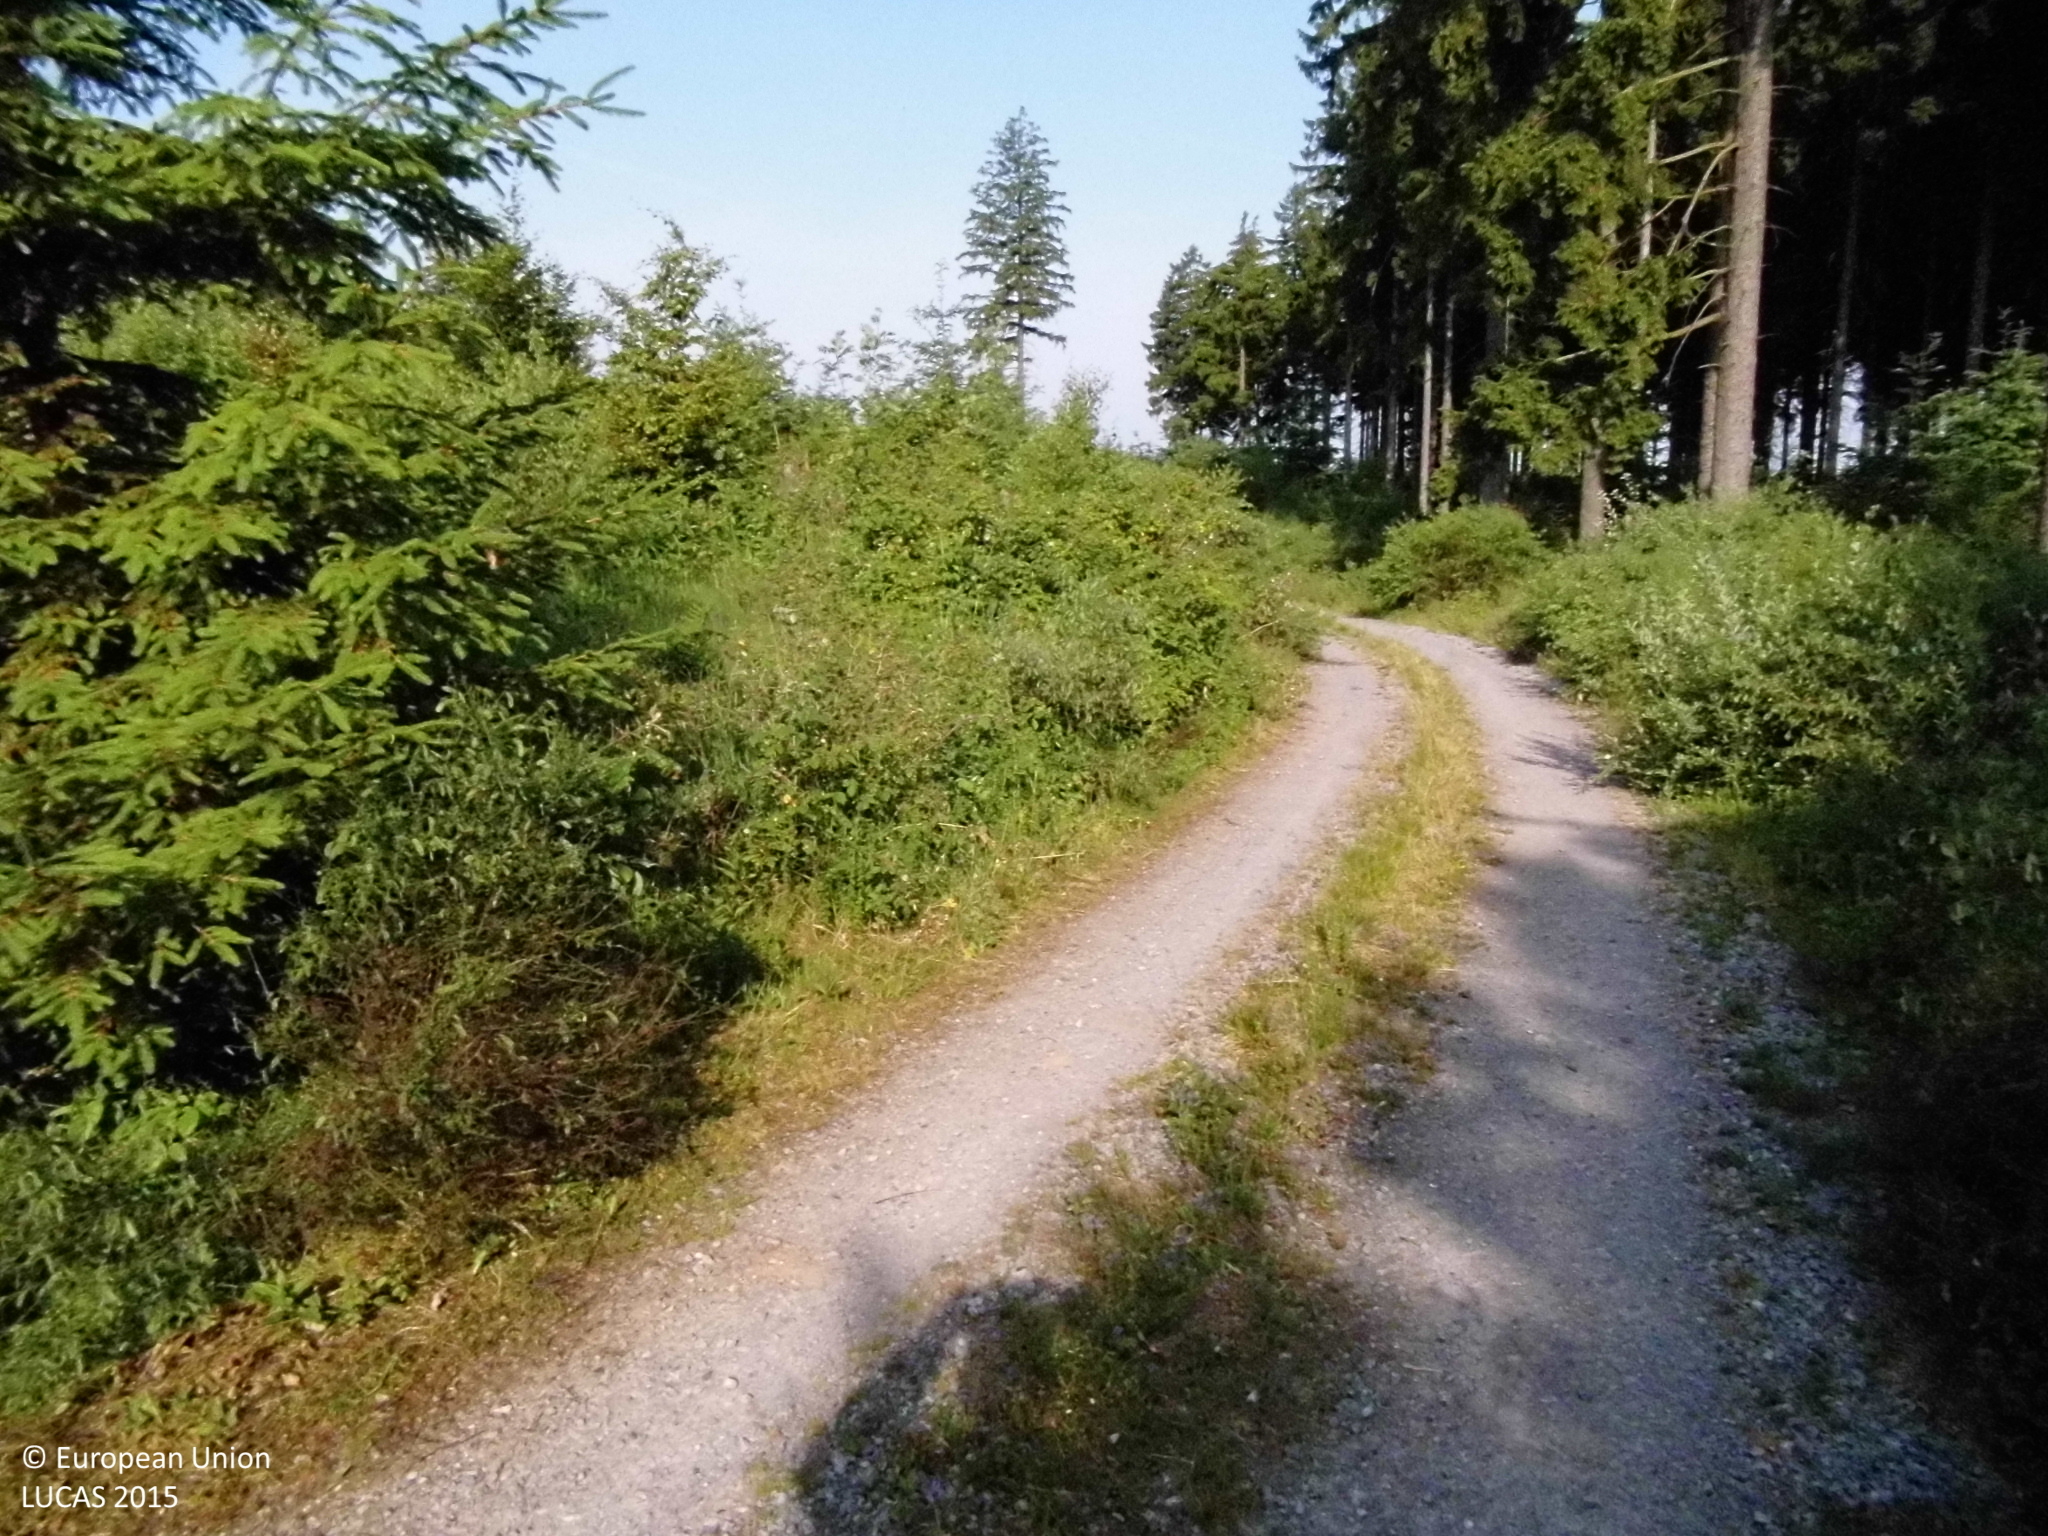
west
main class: Woodland
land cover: Broadleaved woodland
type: mesophytic deciduous forest
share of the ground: > 75 %
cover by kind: broadleaved forest trees 100 %
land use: Forestry
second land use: Amenities, museums, leisure
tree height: > 5 m
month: July
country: DE
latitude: 51.2639
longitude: 8.0083
